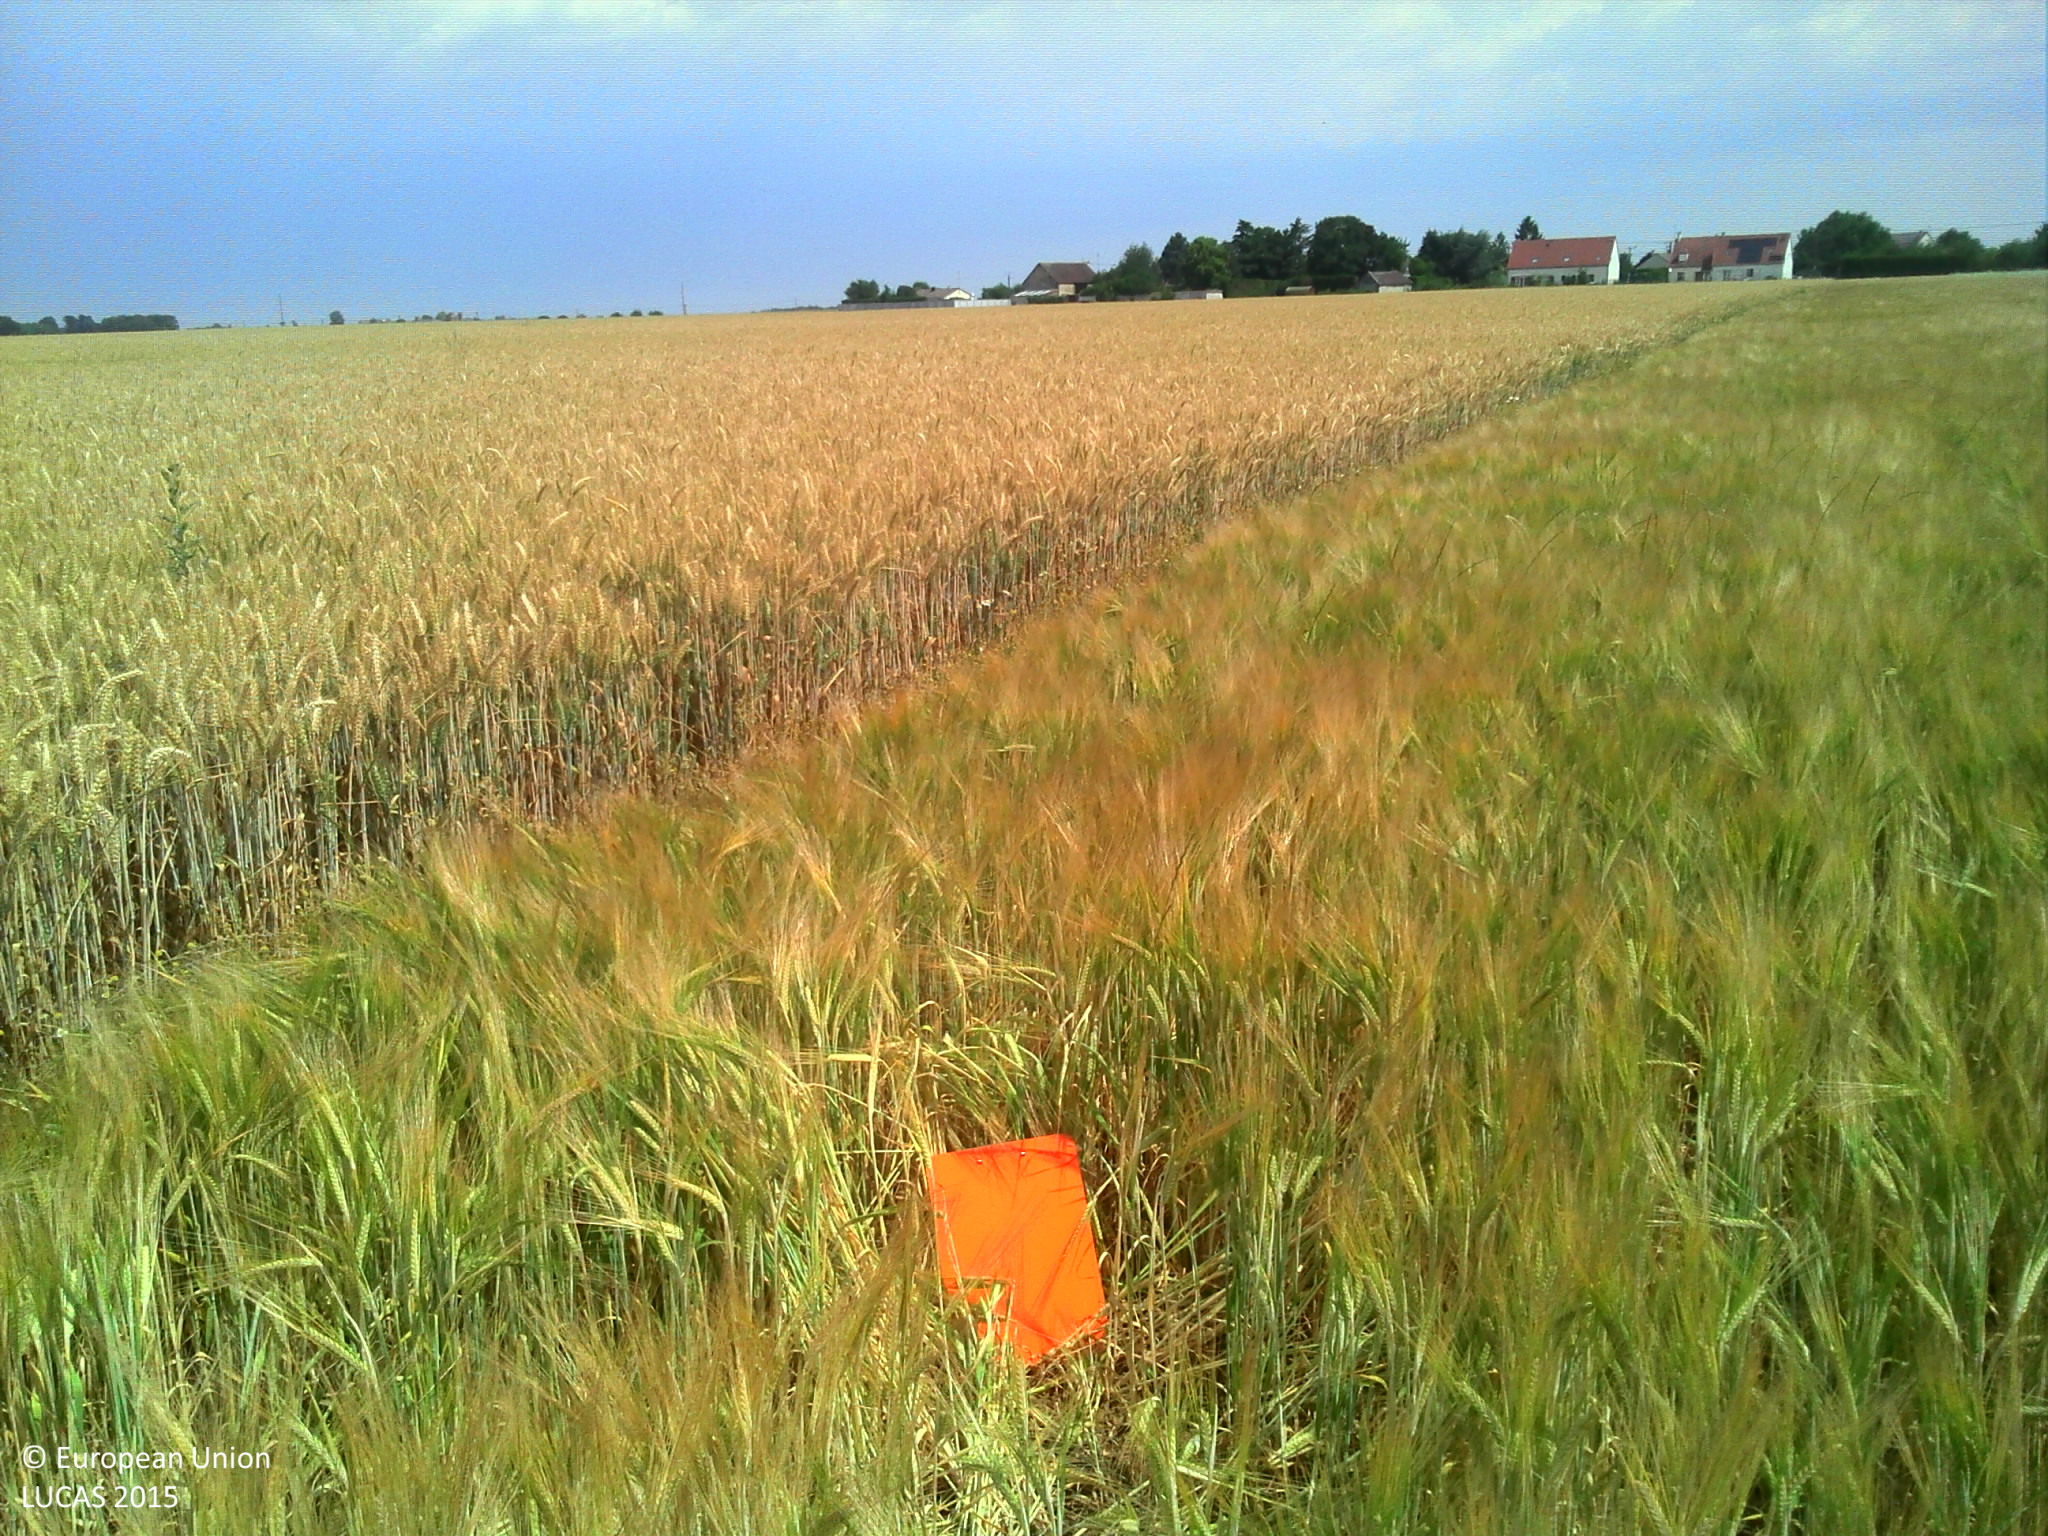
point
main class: Cropland
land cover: Triticale
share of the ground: > 75 %
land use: Agriculture (excluding fallow land and kitchen gardens)
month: July
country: FR
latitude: 48.8676
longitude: 1.2145
